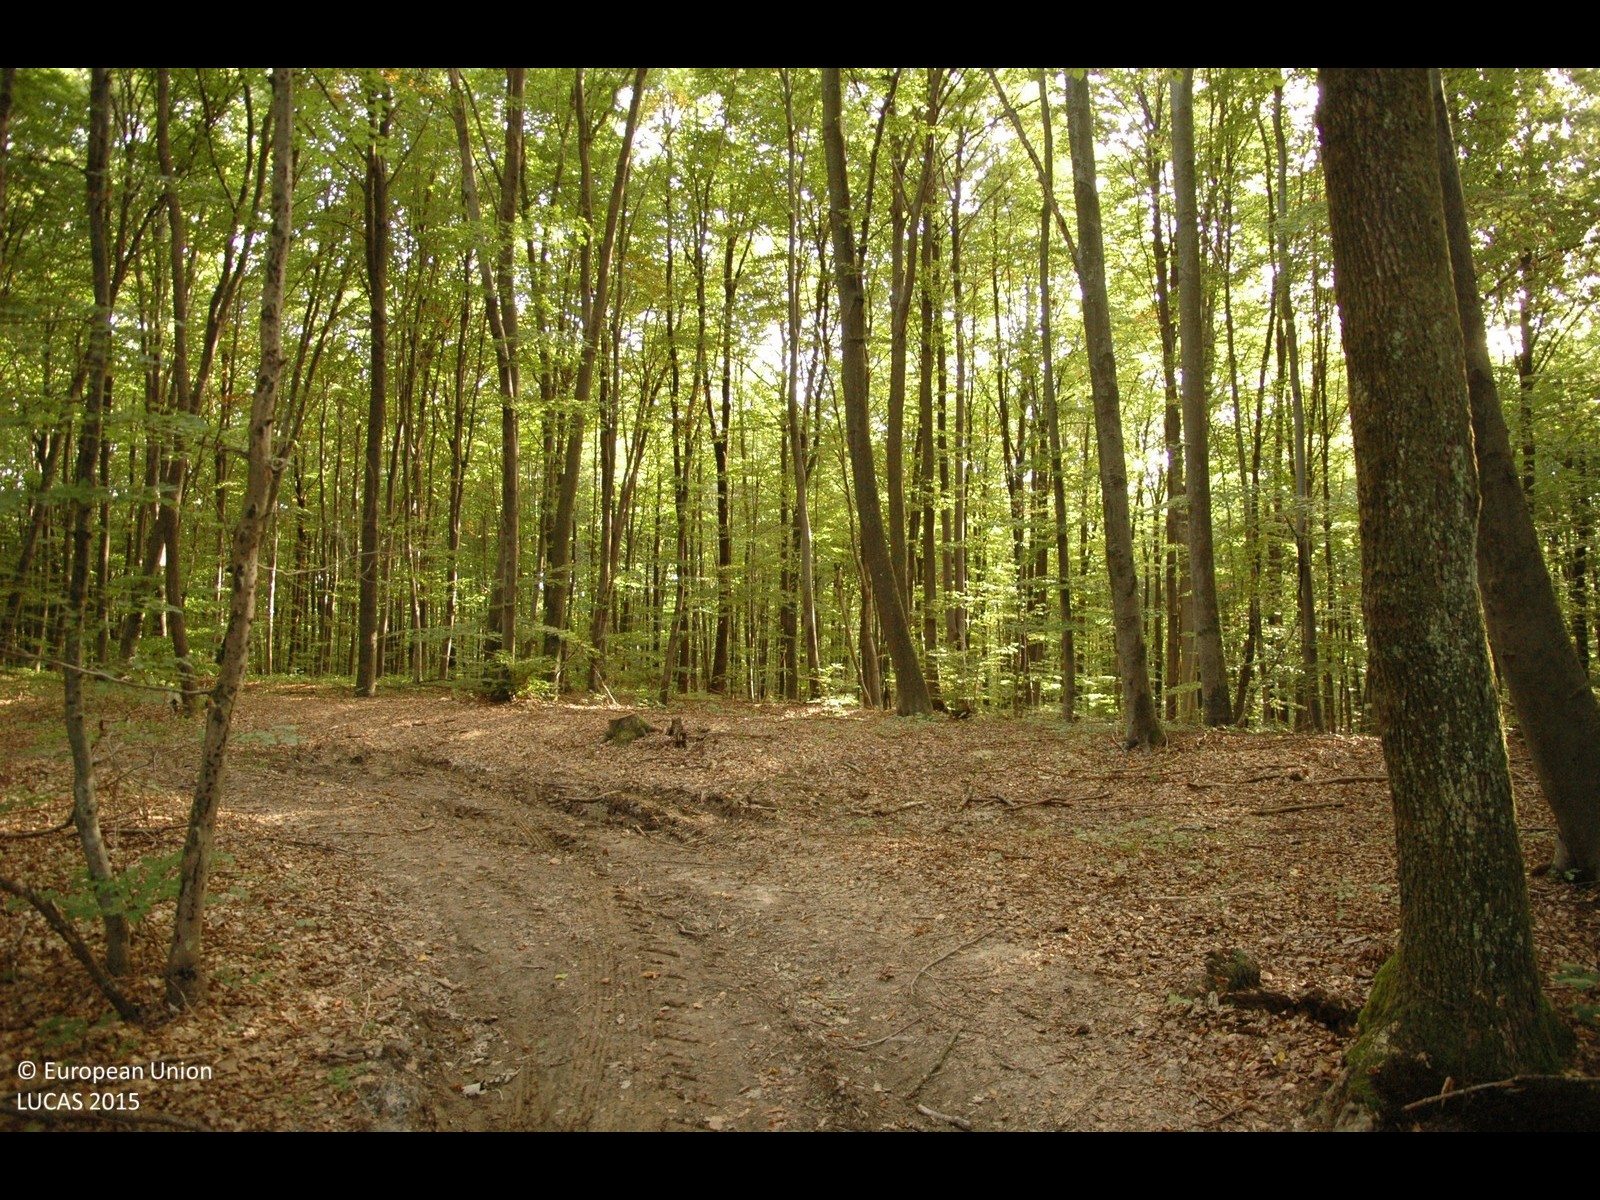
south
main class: Woodland
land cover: Broadleaved woodland
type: mesophytic deciduous forest
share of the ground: > 75 %
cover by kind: broadleaved forest trees 100 %
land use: Forestry
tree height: > 5 m
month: September
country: HR
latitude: 45.6501
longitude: 15.8356
